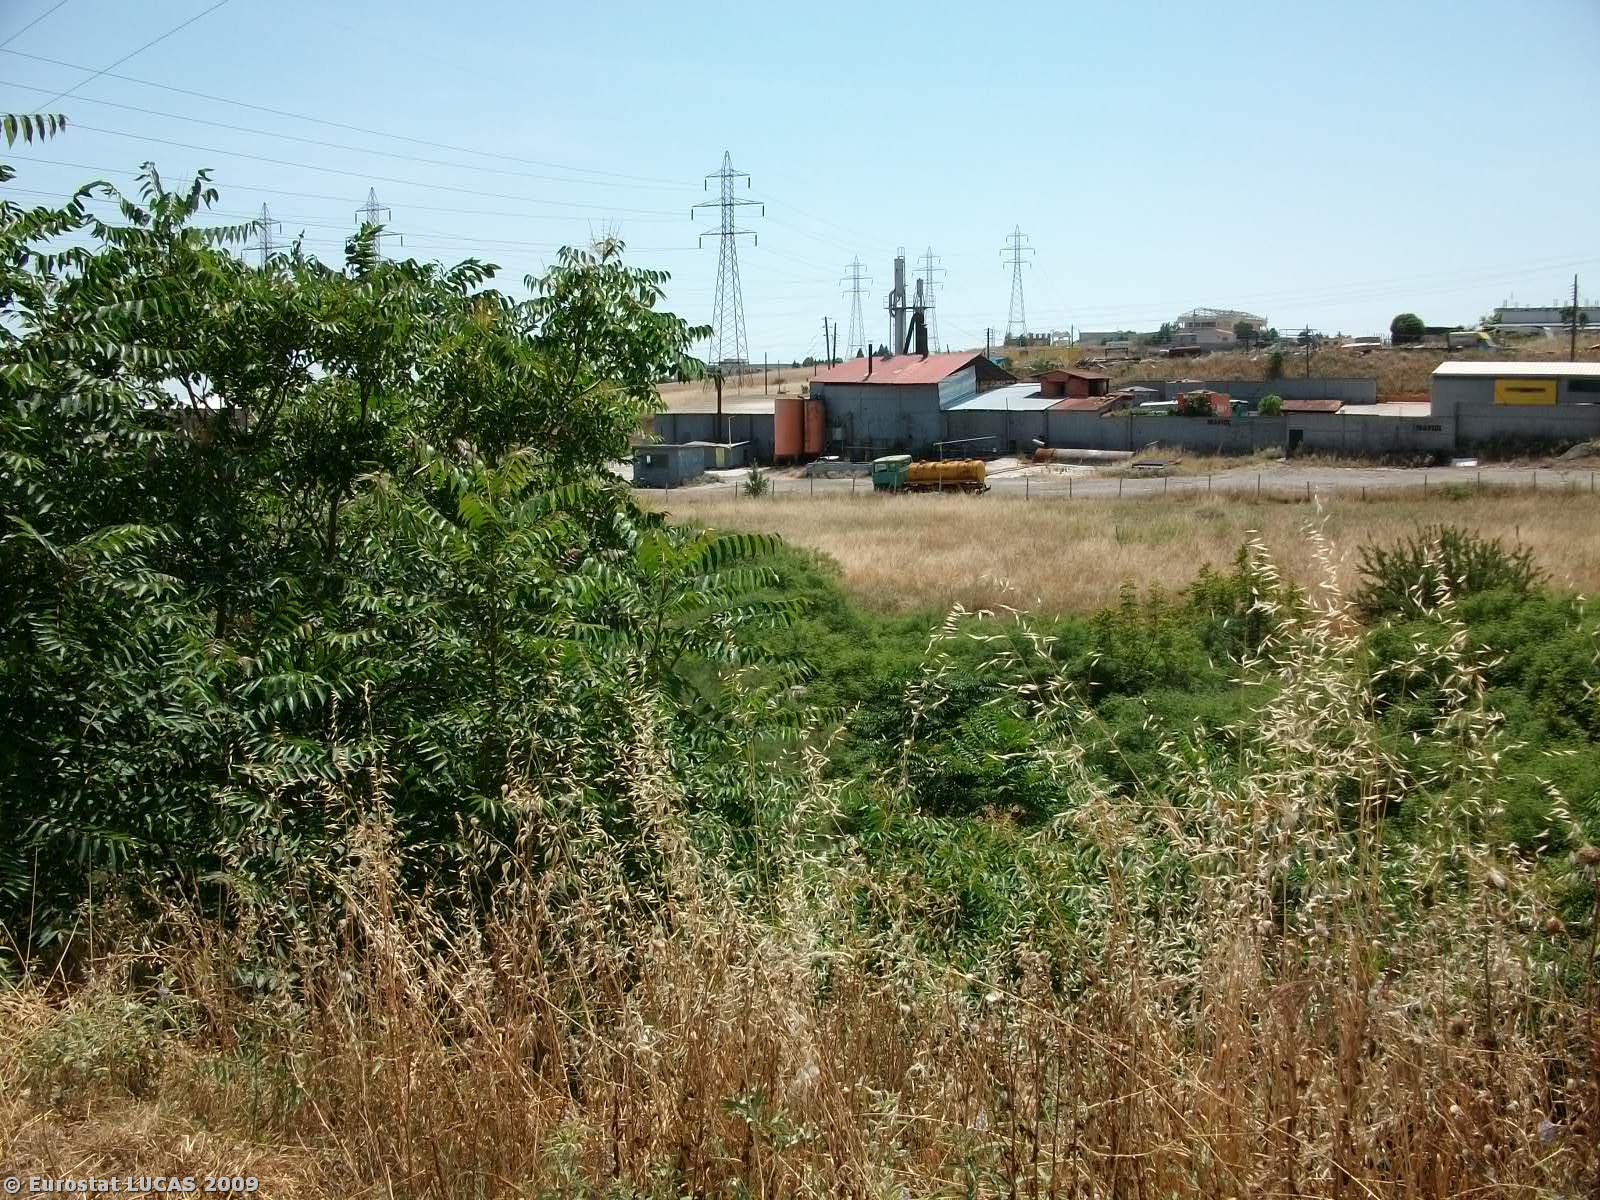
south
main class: Shrubland
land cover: Shrubland with sparse tree cover
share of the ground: > 75 %
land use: Unused
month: June
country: GR
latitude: 40.7047
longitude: 22.9445
